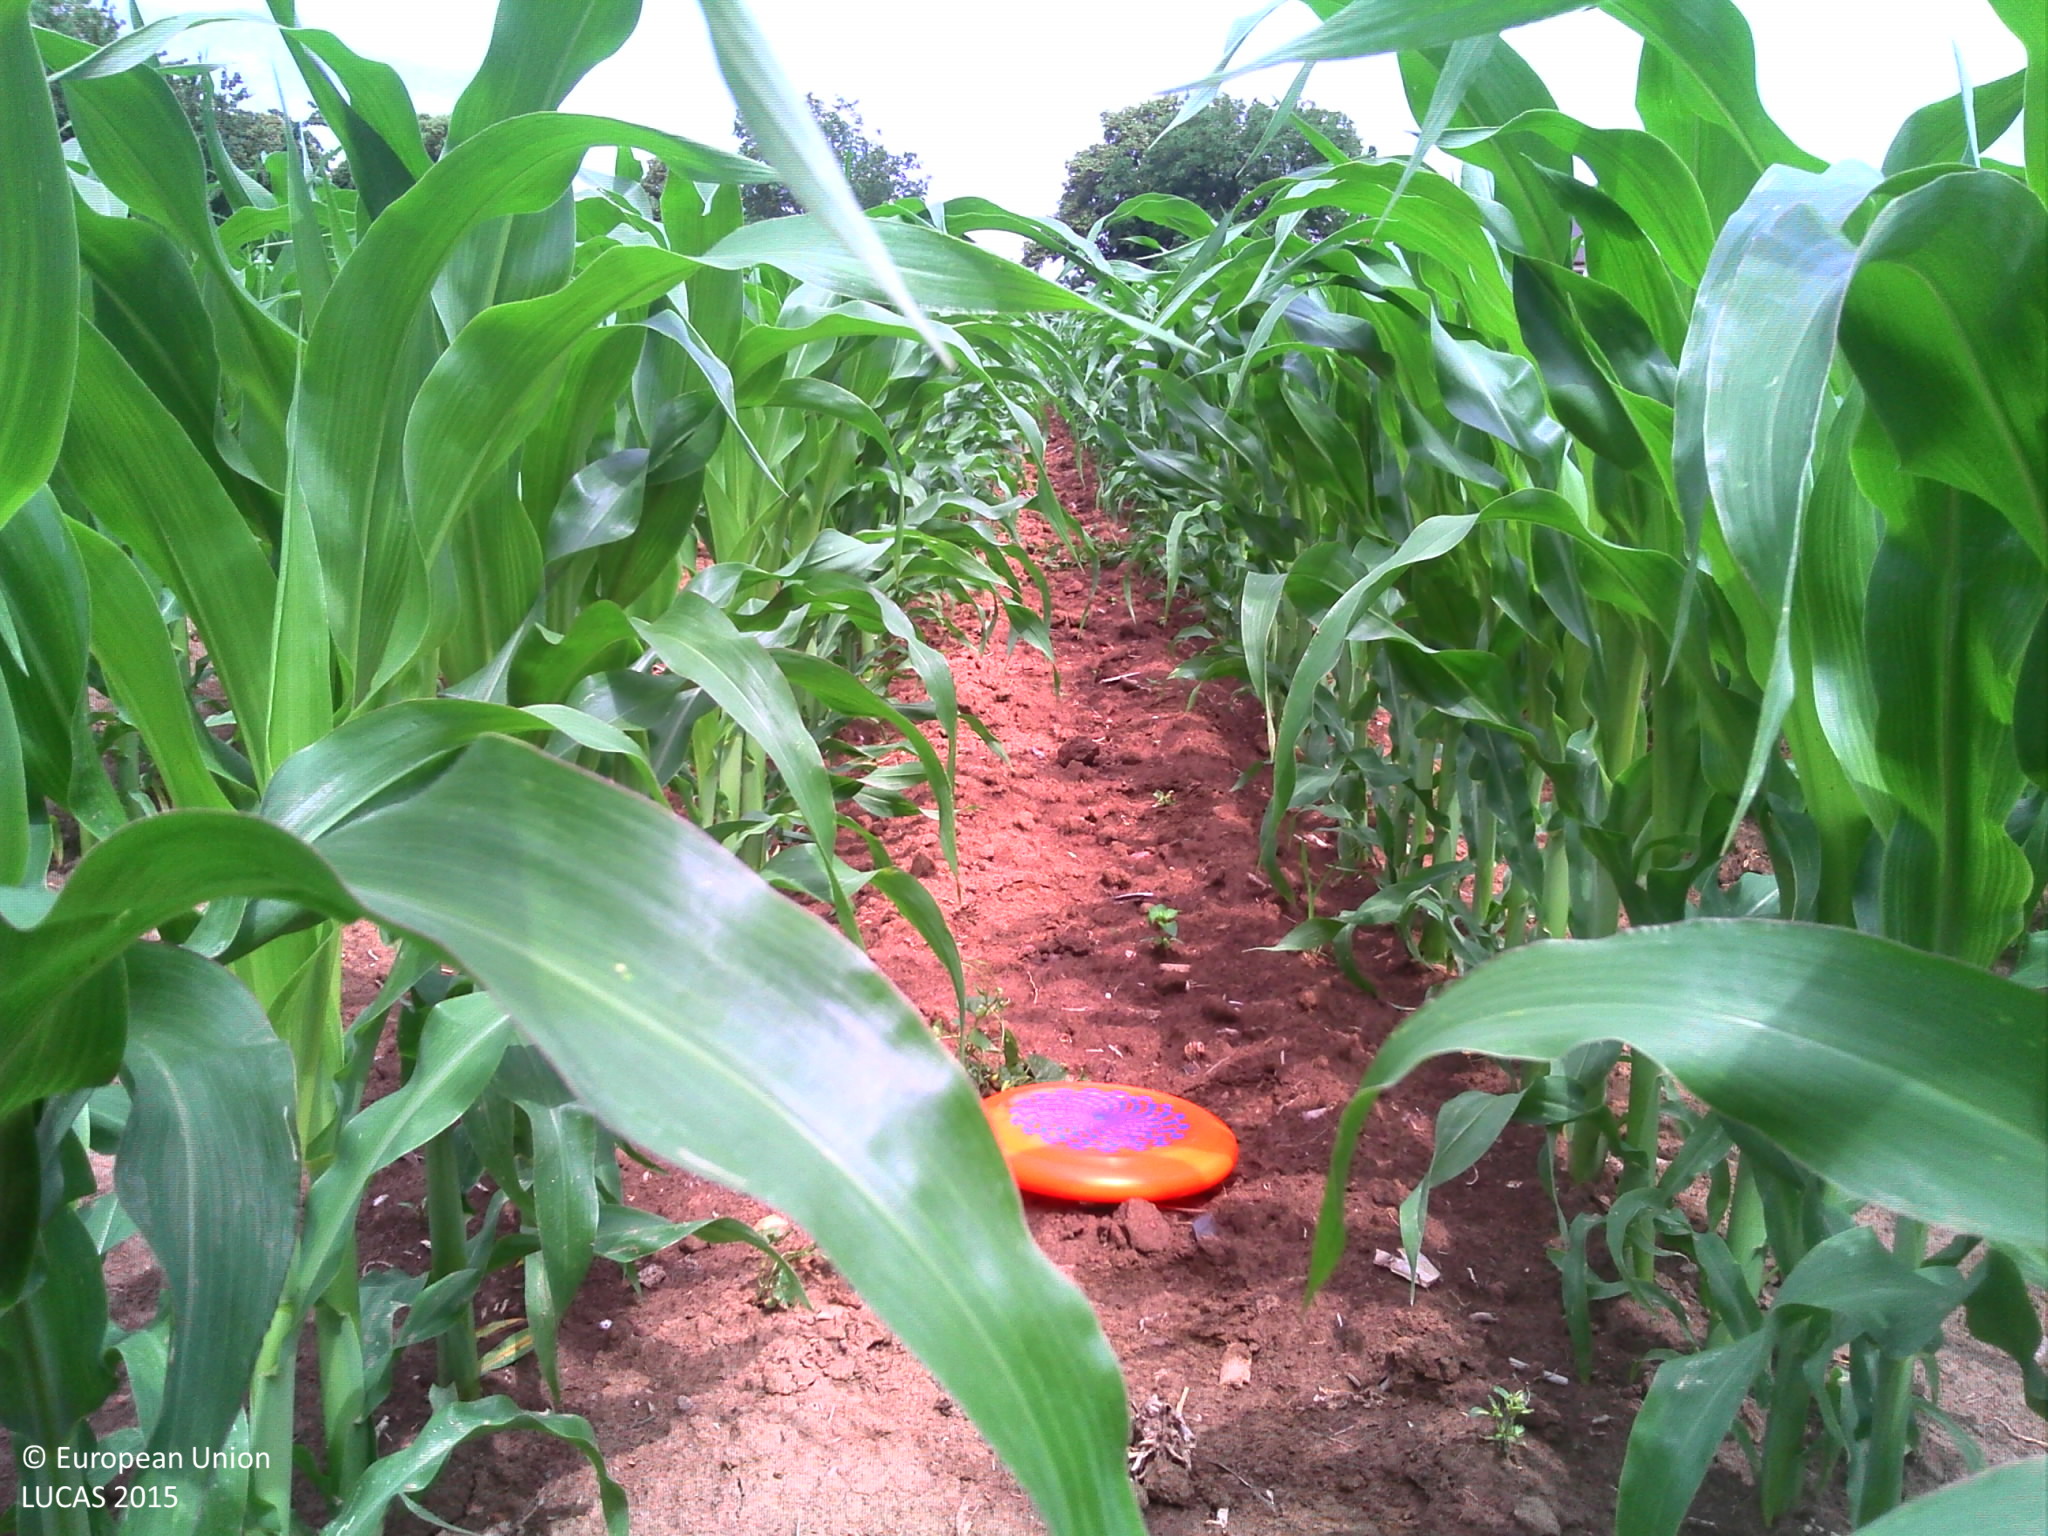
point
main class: Cropland
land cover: Maize
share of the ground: 50 - 75 %
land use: Agriculture (excluding fallow land and kitchen gardens)
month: June
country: FR
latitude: 48.5198
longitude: 7.5232
